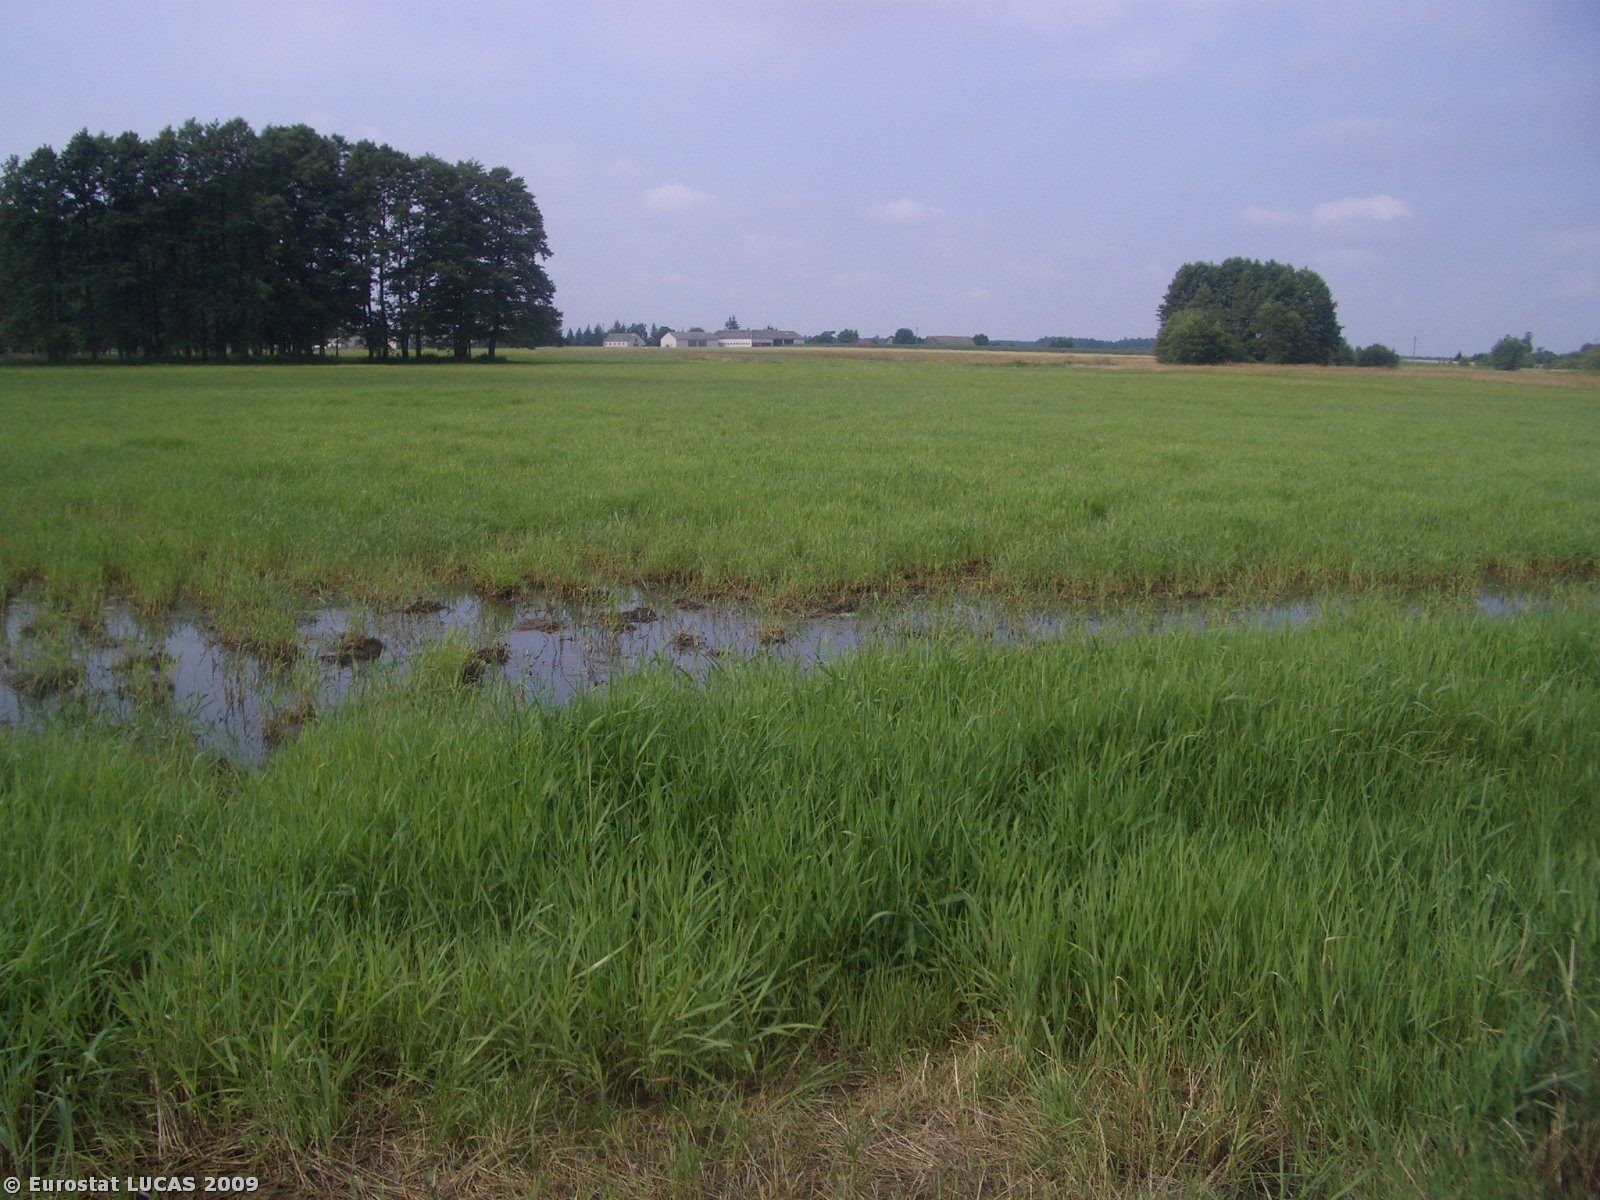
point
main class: Grassland
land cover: Grassland without tree/shrub cover
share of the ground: > 75 %
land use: Agriculture (excluding fallow land and kitchen gardens)
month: July
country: PL
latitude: 52.1023
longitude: 22.6090
